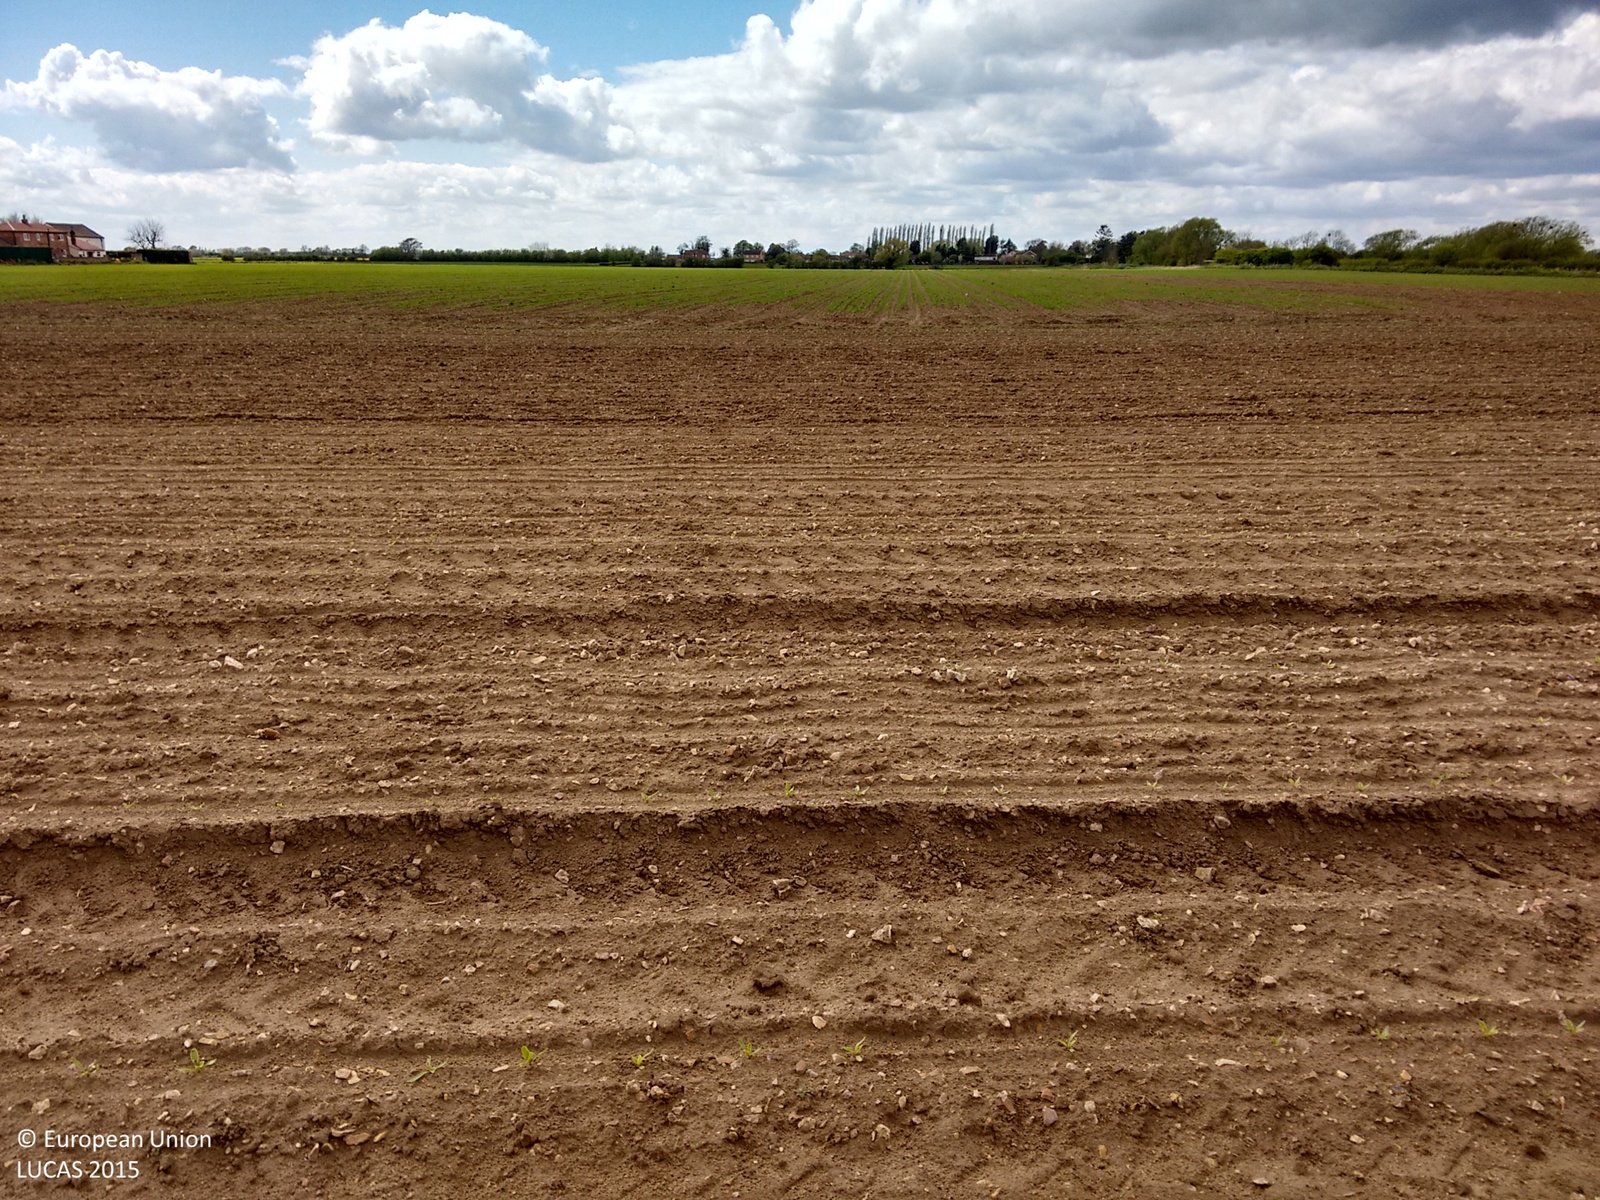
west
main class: Cropland
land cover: Other fresh vegetables
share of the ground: < 10 %
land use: Agriculture (excluding fallow land and kitchen gardens)
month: April
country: GB
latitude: 53.0814
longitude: -0.1705
